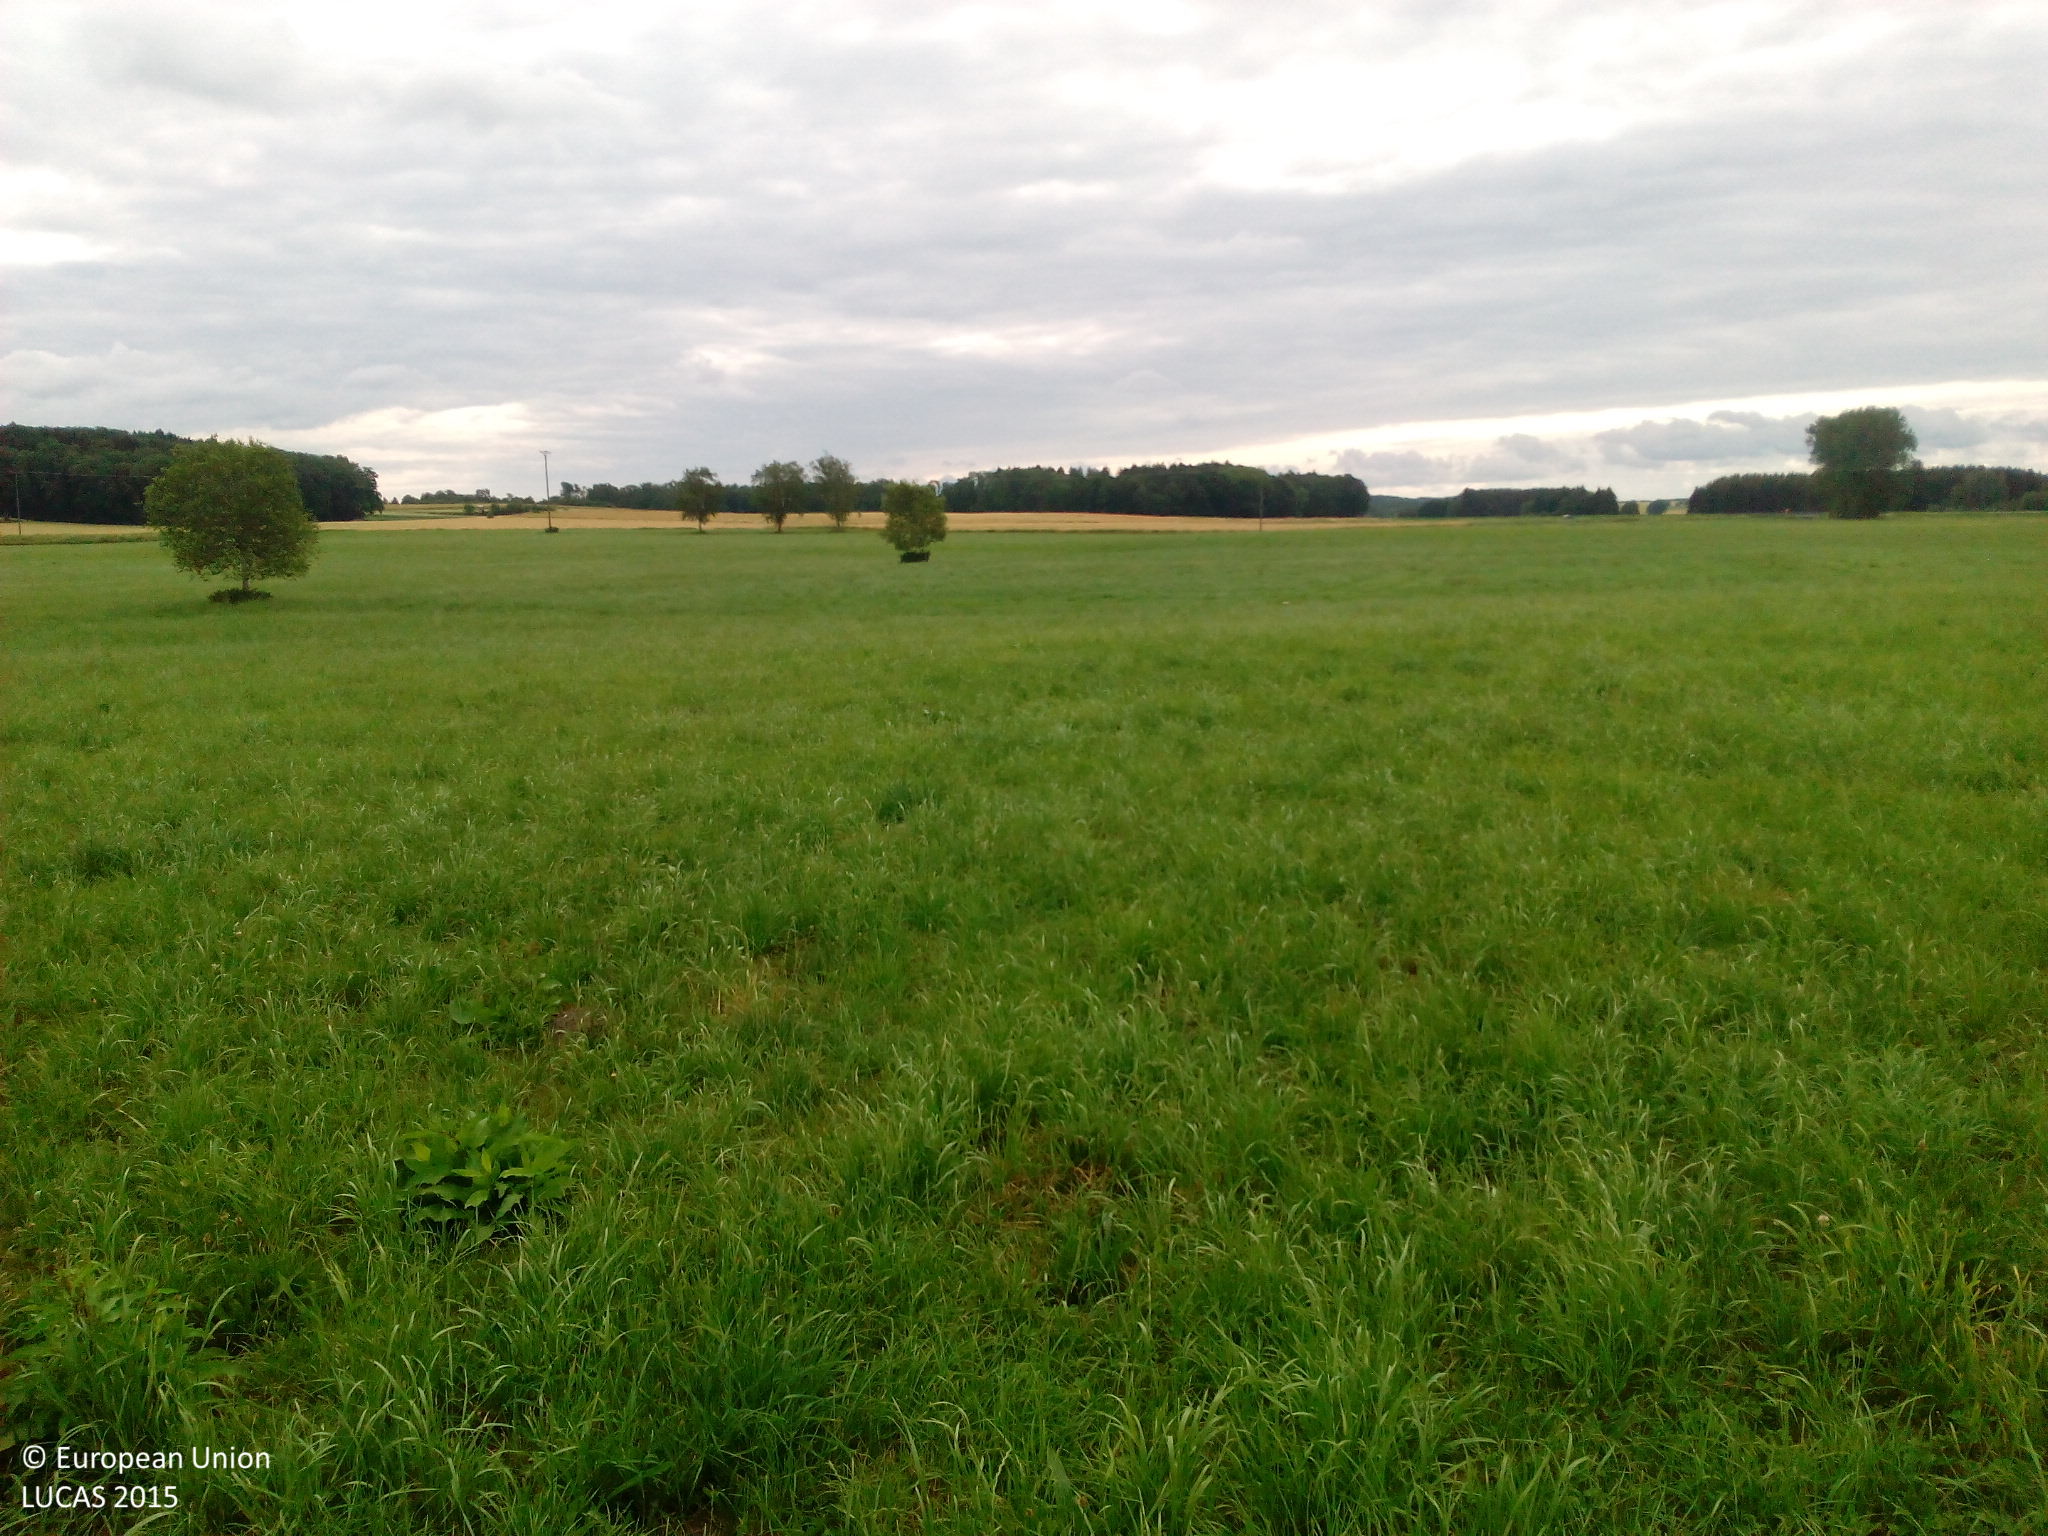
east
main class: Grassland
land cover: Grassland without tree/shrub cover
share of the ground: > 75 %
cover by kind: herbaceous plants 100 %
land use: Agriculture (excluding fallow land and kitchen gardens)
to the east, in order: Grassland without tree/shrub cover; Single bushes/trees; Grassland without tree/shrub cover; Ditches and canals; Grassland without tree/shrub cover
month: July
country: DE
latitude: 47.8981
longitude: 9.4252
